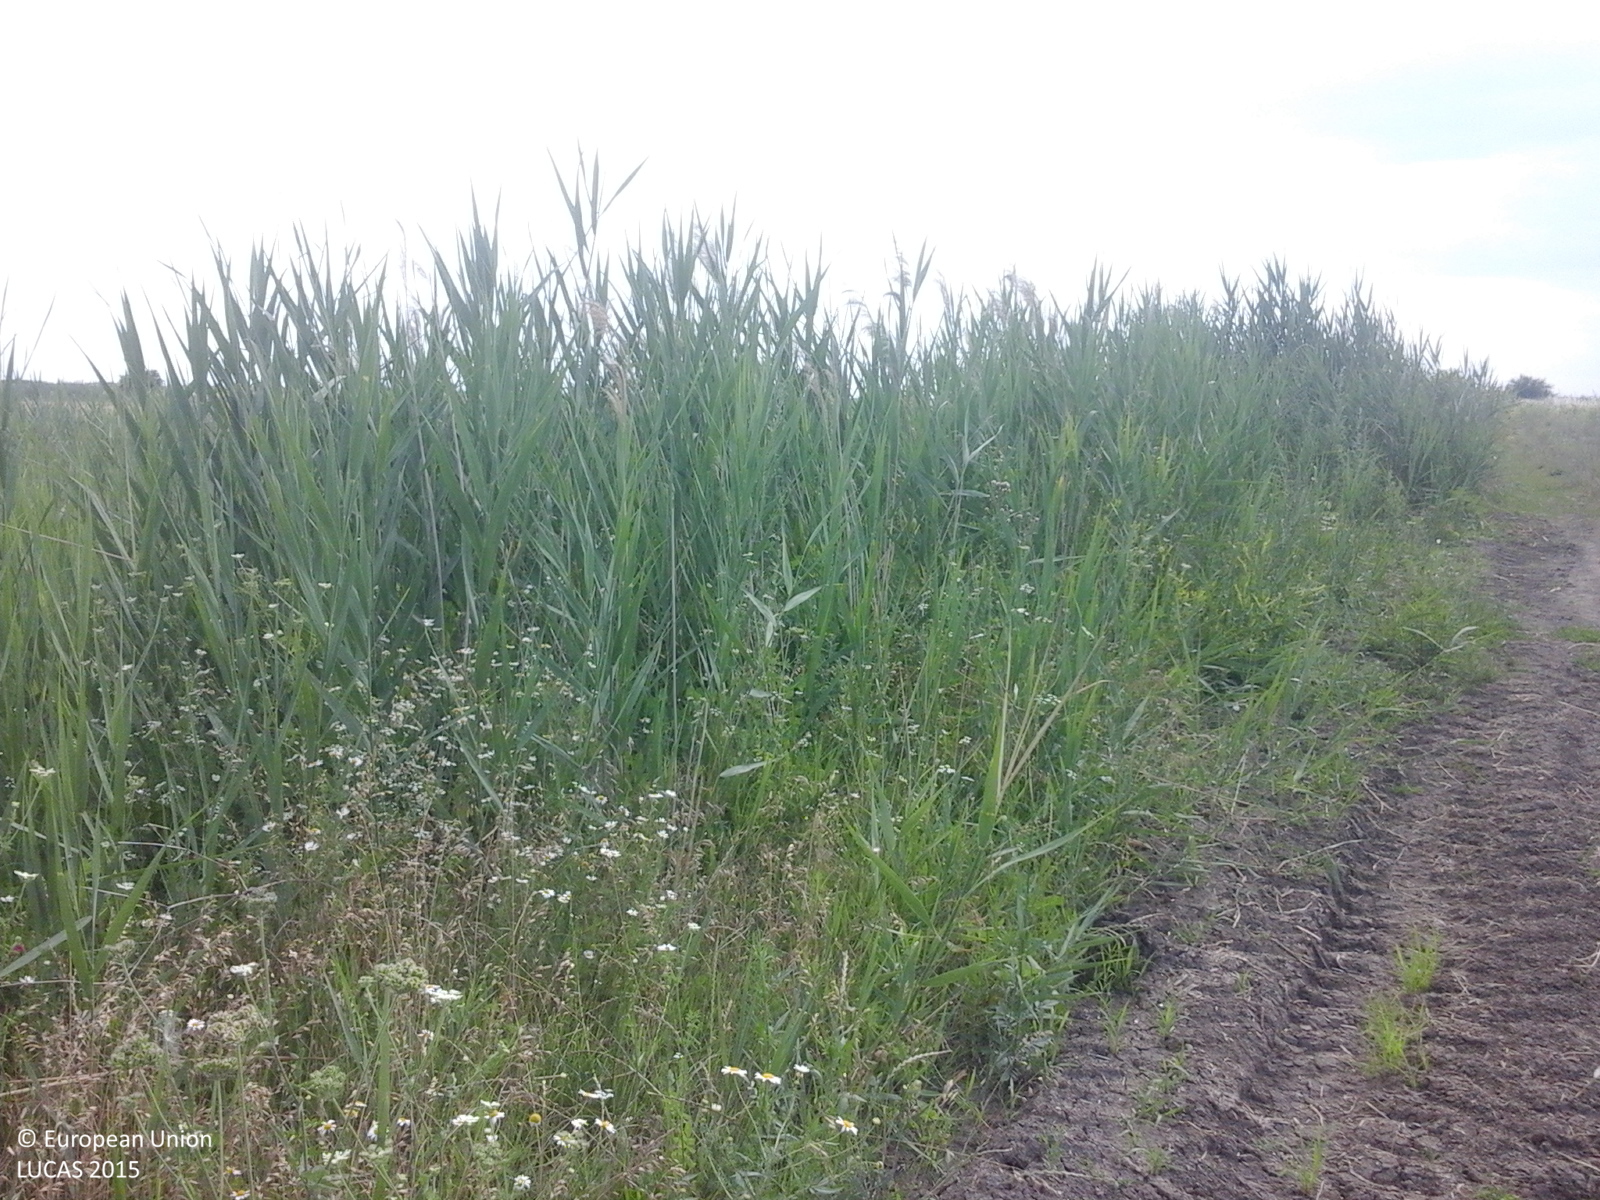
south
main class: Grassland
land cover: Spontaneously vegetated surfaces
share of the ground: > 75 %
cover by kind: herbaceous plants 100 %
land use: Semi-natural and natural areas not in use
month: June
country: RO
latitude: 44.0968
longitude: 26.5383
